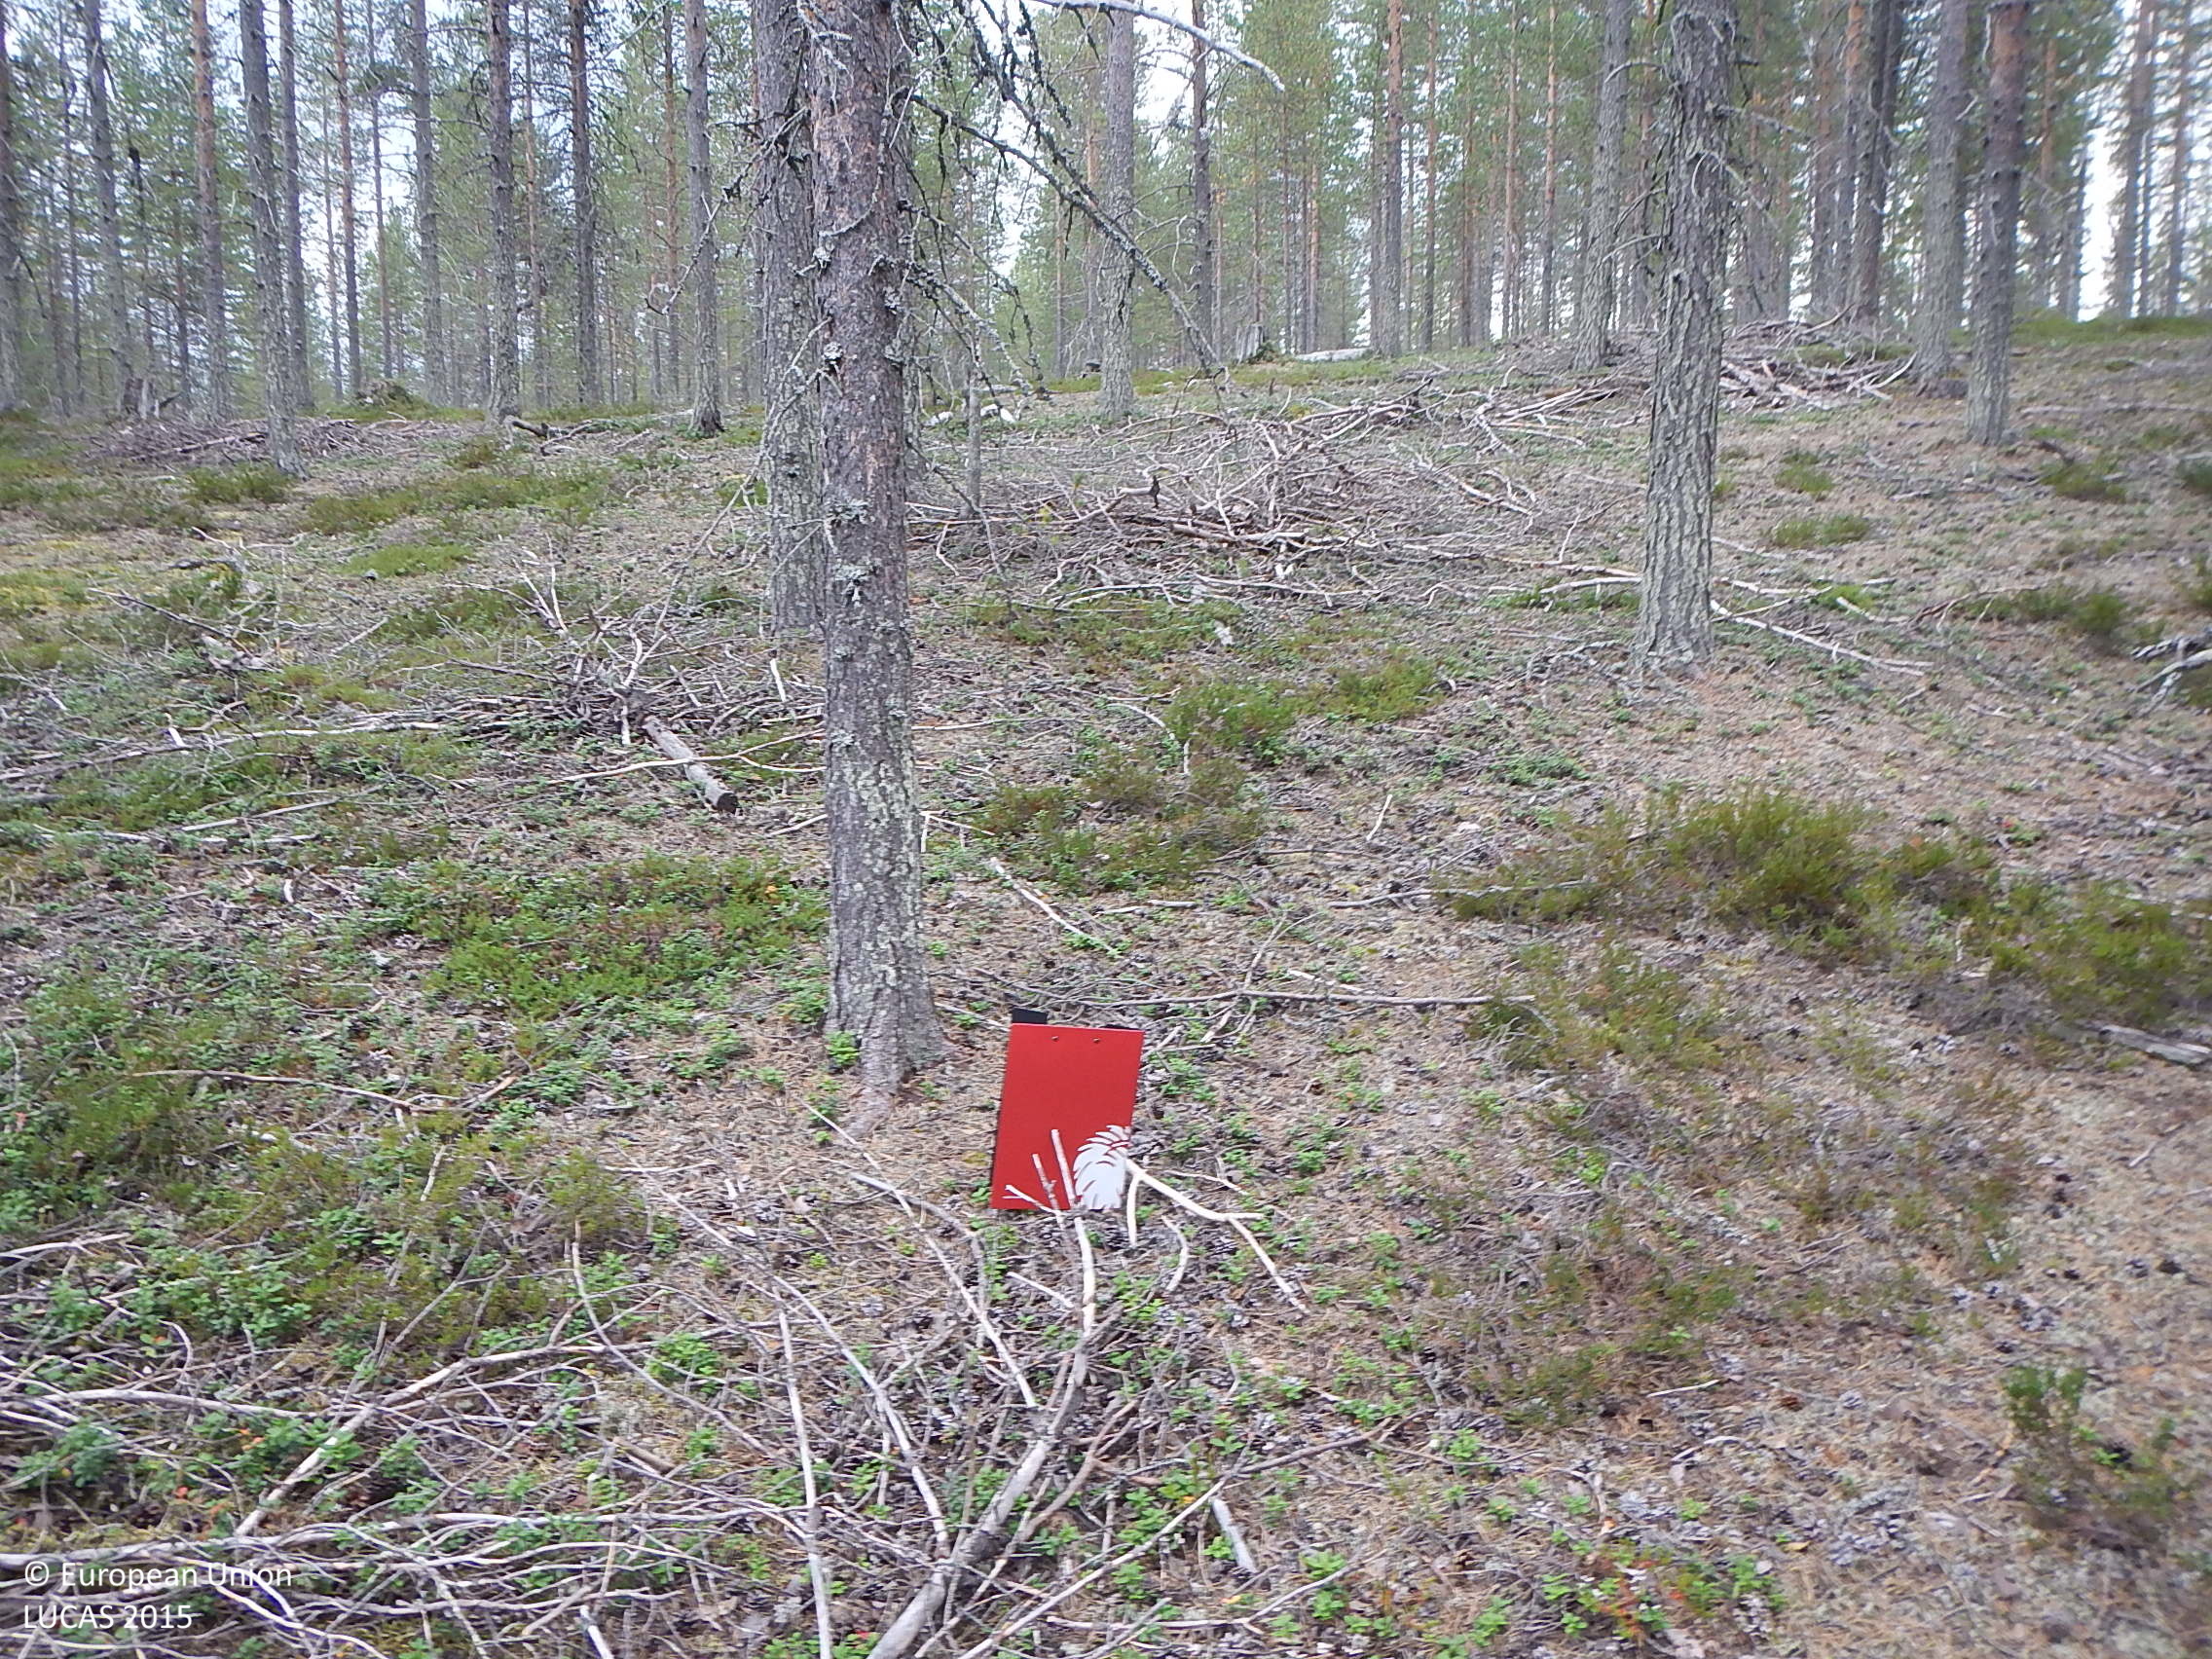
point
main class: Woodland
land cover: Pine dominated coniferous woodland
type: boreal forest
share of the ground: 50 - 75 %
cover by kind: coniferous forest trees 60 %, shrubs 30 %, lichens and mosses 10 %
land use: Forestry
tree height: > 5 m
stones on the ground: < 10 %
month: August
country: FI
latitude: 66.0489
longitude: 27.7676
